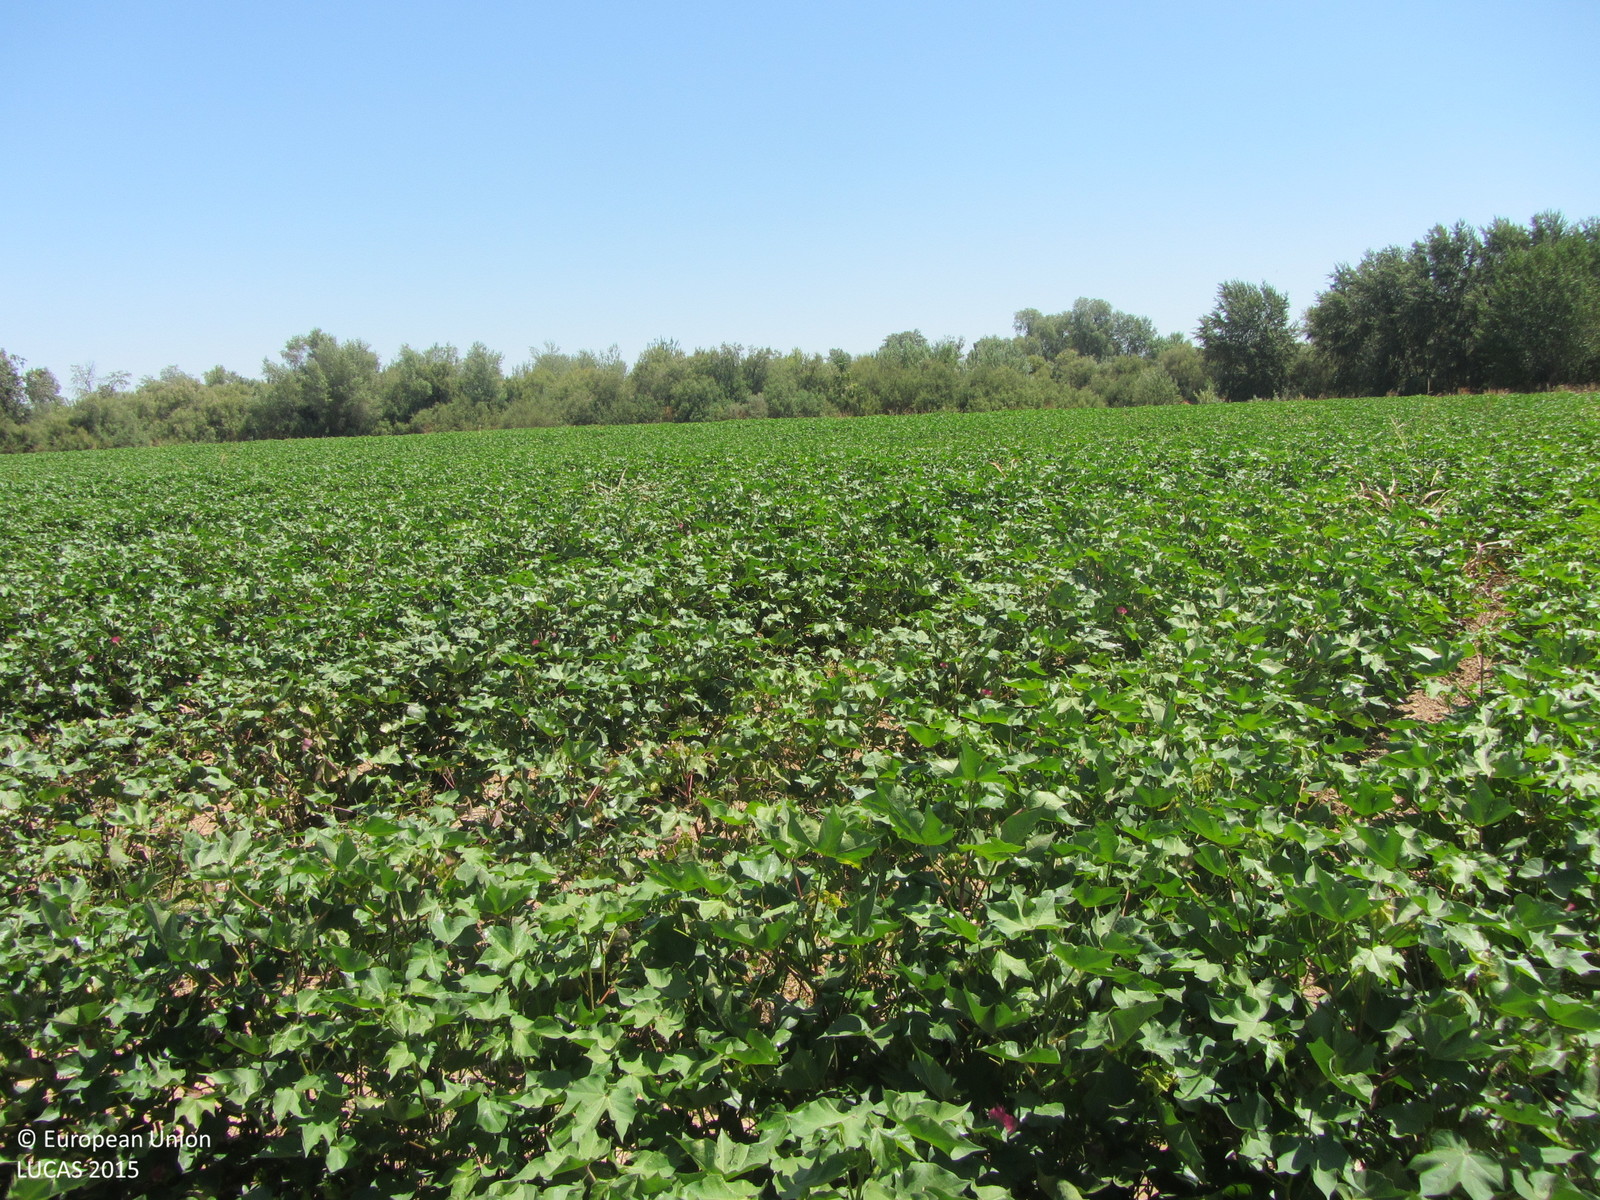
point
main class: Cropland
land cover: Cotton
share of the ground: > 75 %
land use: Agriculture (excluding fallow land and kitchen gardens)
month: July
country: ES
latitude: 38.0183
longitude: -3.8218
